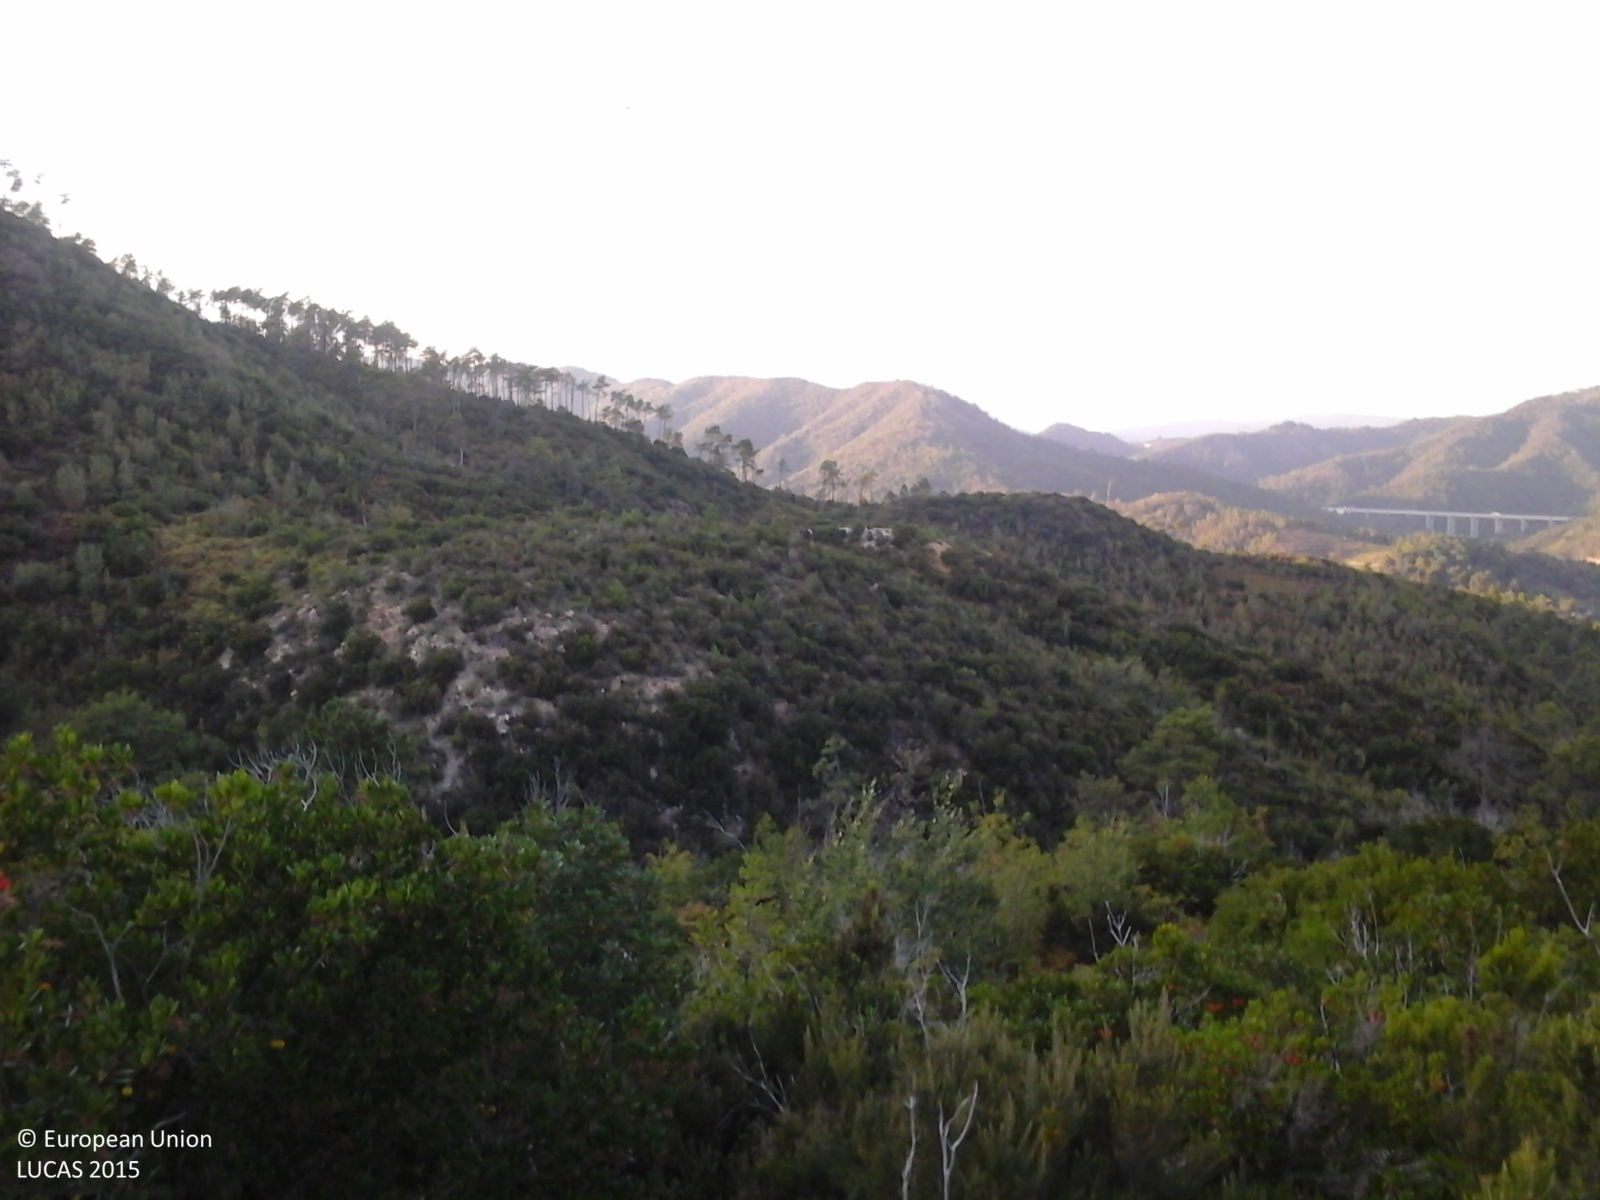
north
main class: Shrubland
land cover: Shrubland without tree cover
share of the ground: > 75 %
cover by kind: shrubs 80 %, herbaceous plants 10 %, consolidated bare surface 10 %
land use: Semi-natural and natural areas not in use
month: September
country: IT
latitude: 44.2843
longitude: 8.4122
